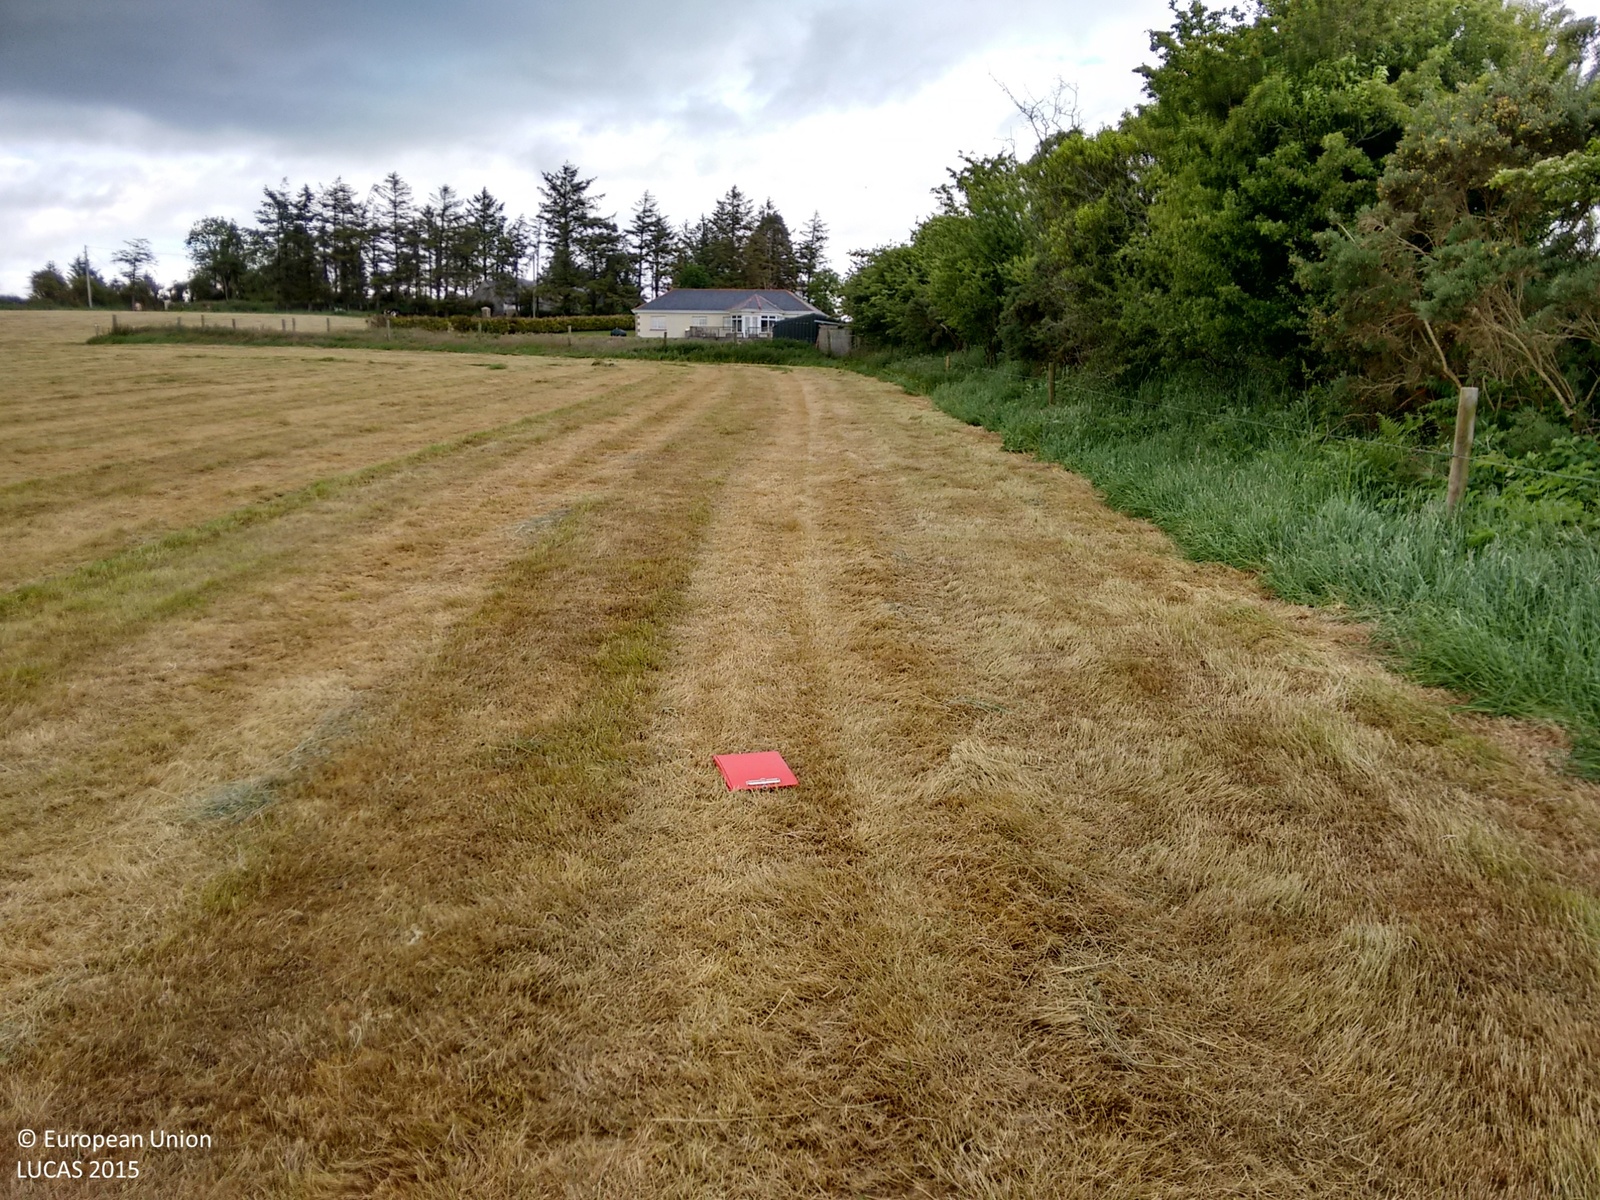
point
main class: Grassland
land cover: Grassland without tree/shrub cover
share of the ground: > 75 %
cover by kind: herbaceous plants 100 %
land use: Agriculture (excluding fallow land and kitchen gardens)
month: June
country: IE
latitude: 52.2088
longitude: -7.3493
